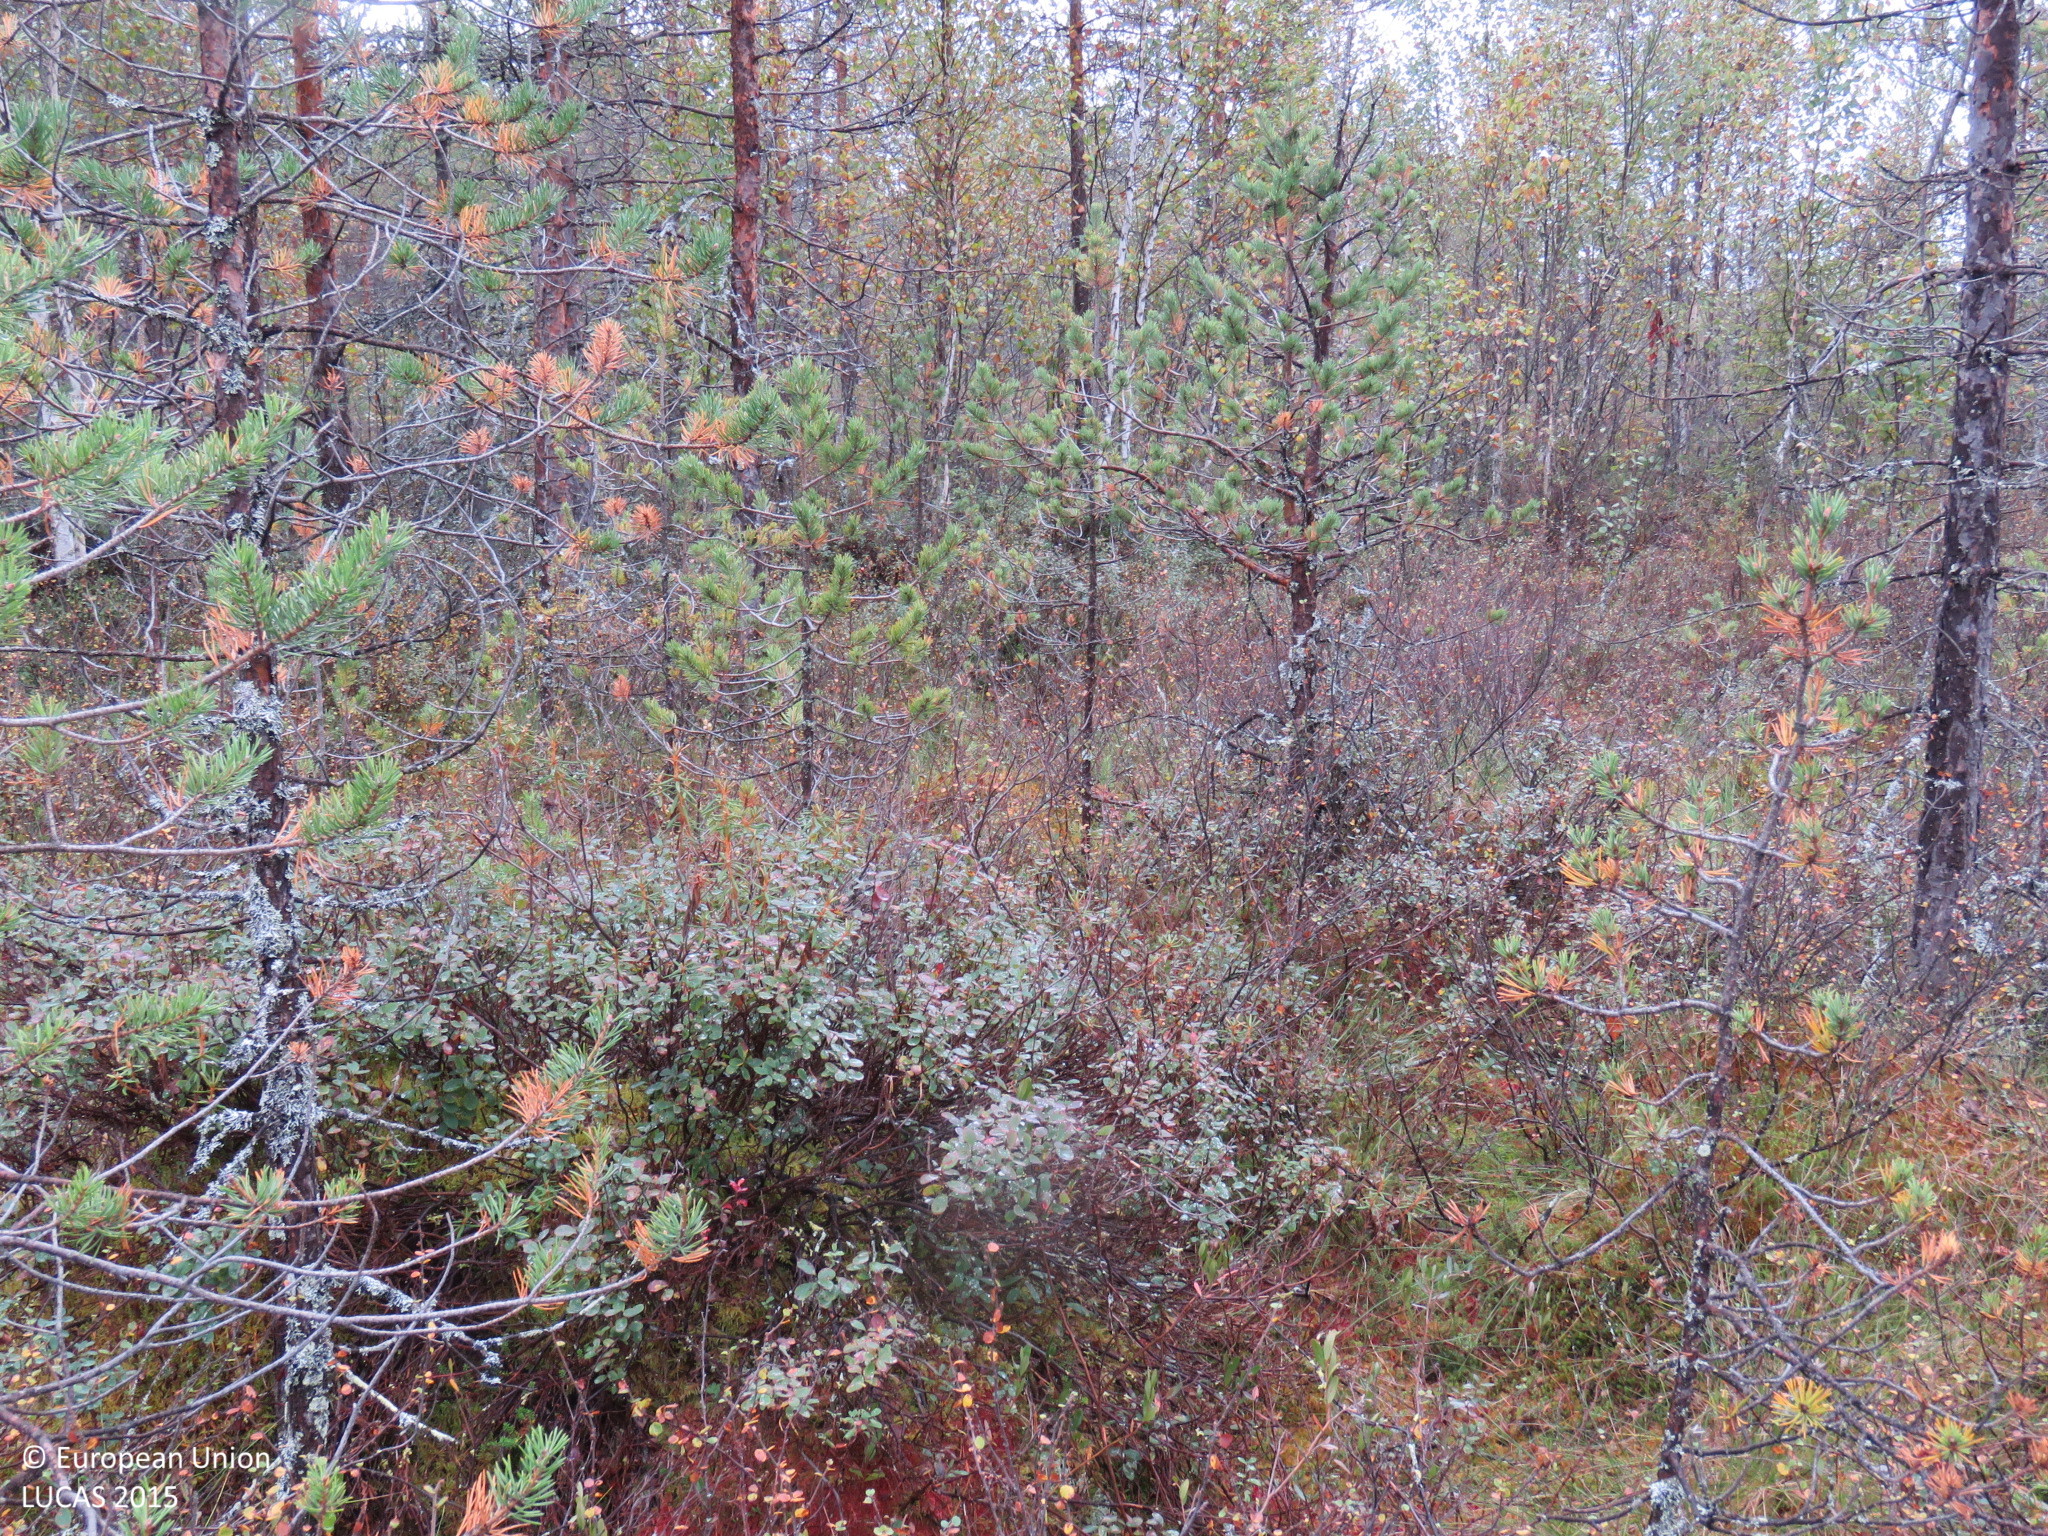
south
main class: Woodland
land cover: Pine dominated coniferous woodland
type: mire and swamp forests
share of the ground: > 75 %
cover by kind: coniferous forest trees 60 %, broadleaved forest trees 15 %, shrubs 15 %, herbaceous plants 5 %, lichens and mosses 5 %
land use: Forestry
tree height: > 5 m
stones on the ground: < 10 %
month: September
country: FI
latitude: 65.2788
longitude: 27.4685
